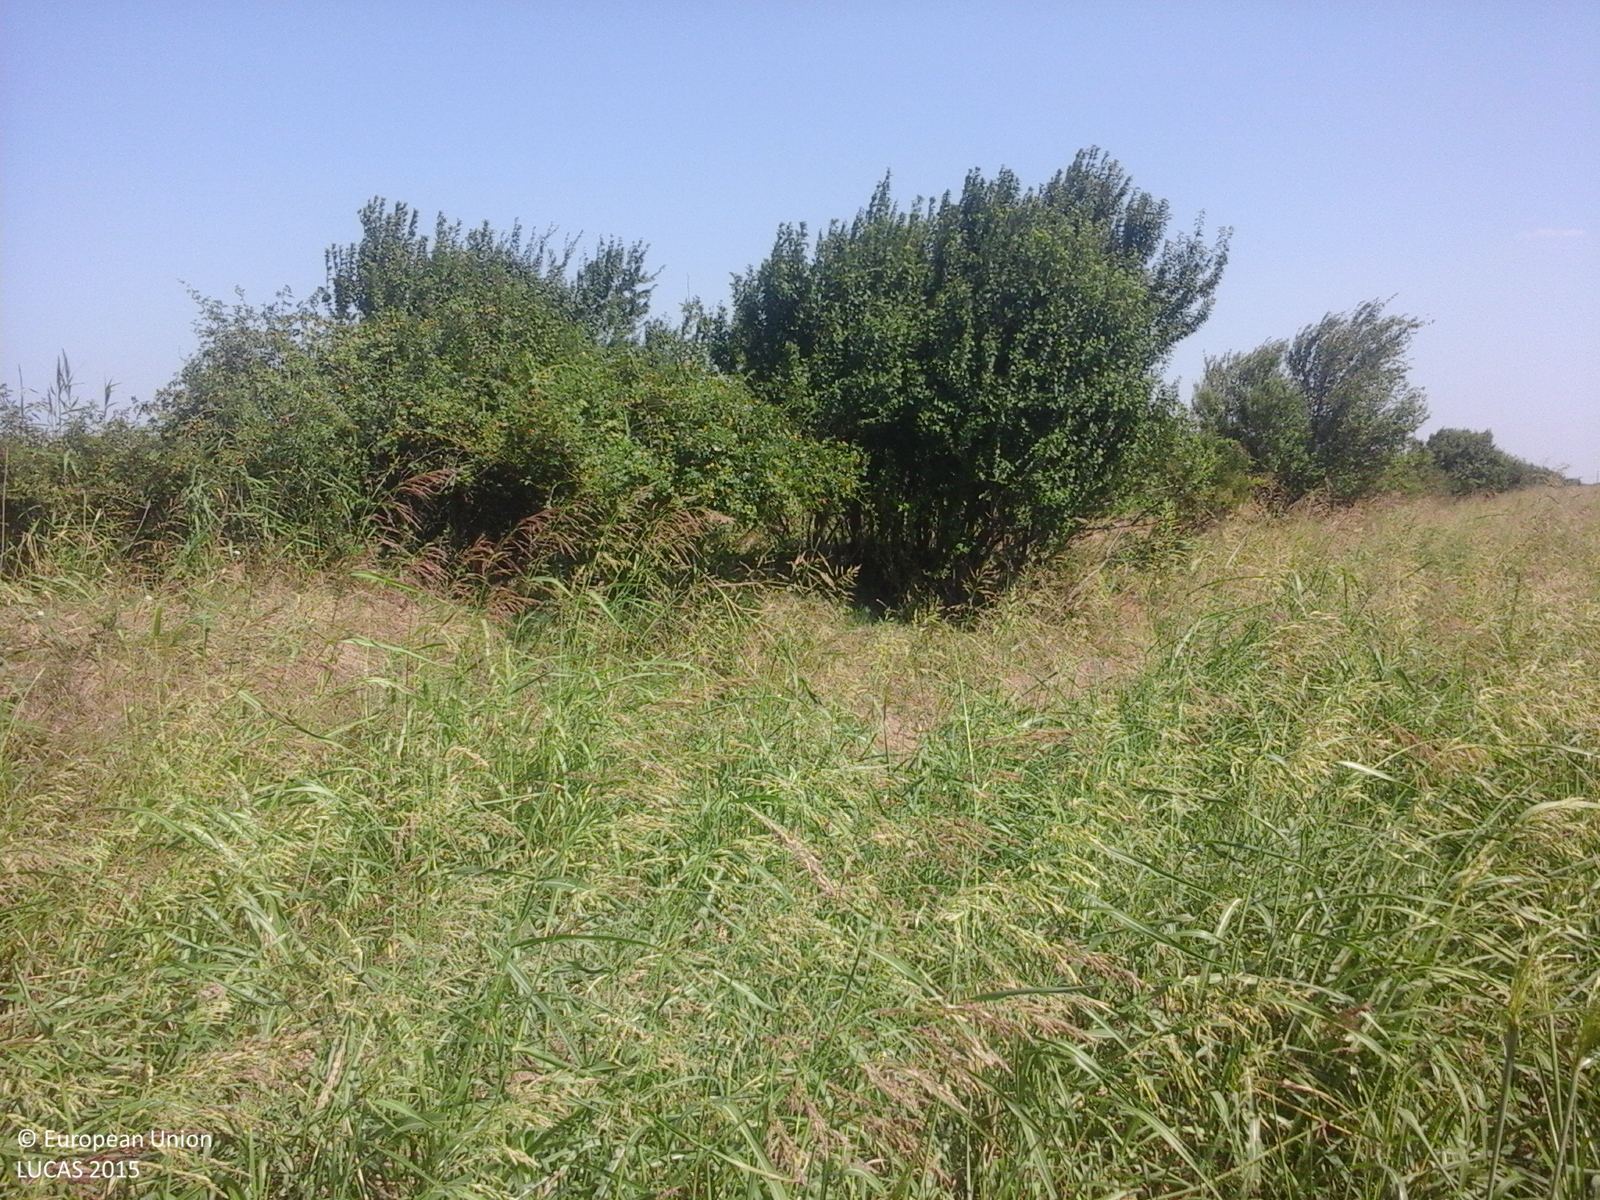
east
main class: Cropland
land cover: Maize
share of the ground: > 75 %
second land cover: Spontaneously vegetated surfaces
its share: > 75 %
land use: Agriculture (excluding fallow land and kitchen gardens)
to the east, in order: Maize; Spontaneously vegetated surfaces
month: August
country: RO
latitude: 45.1265
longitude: 26.8762
